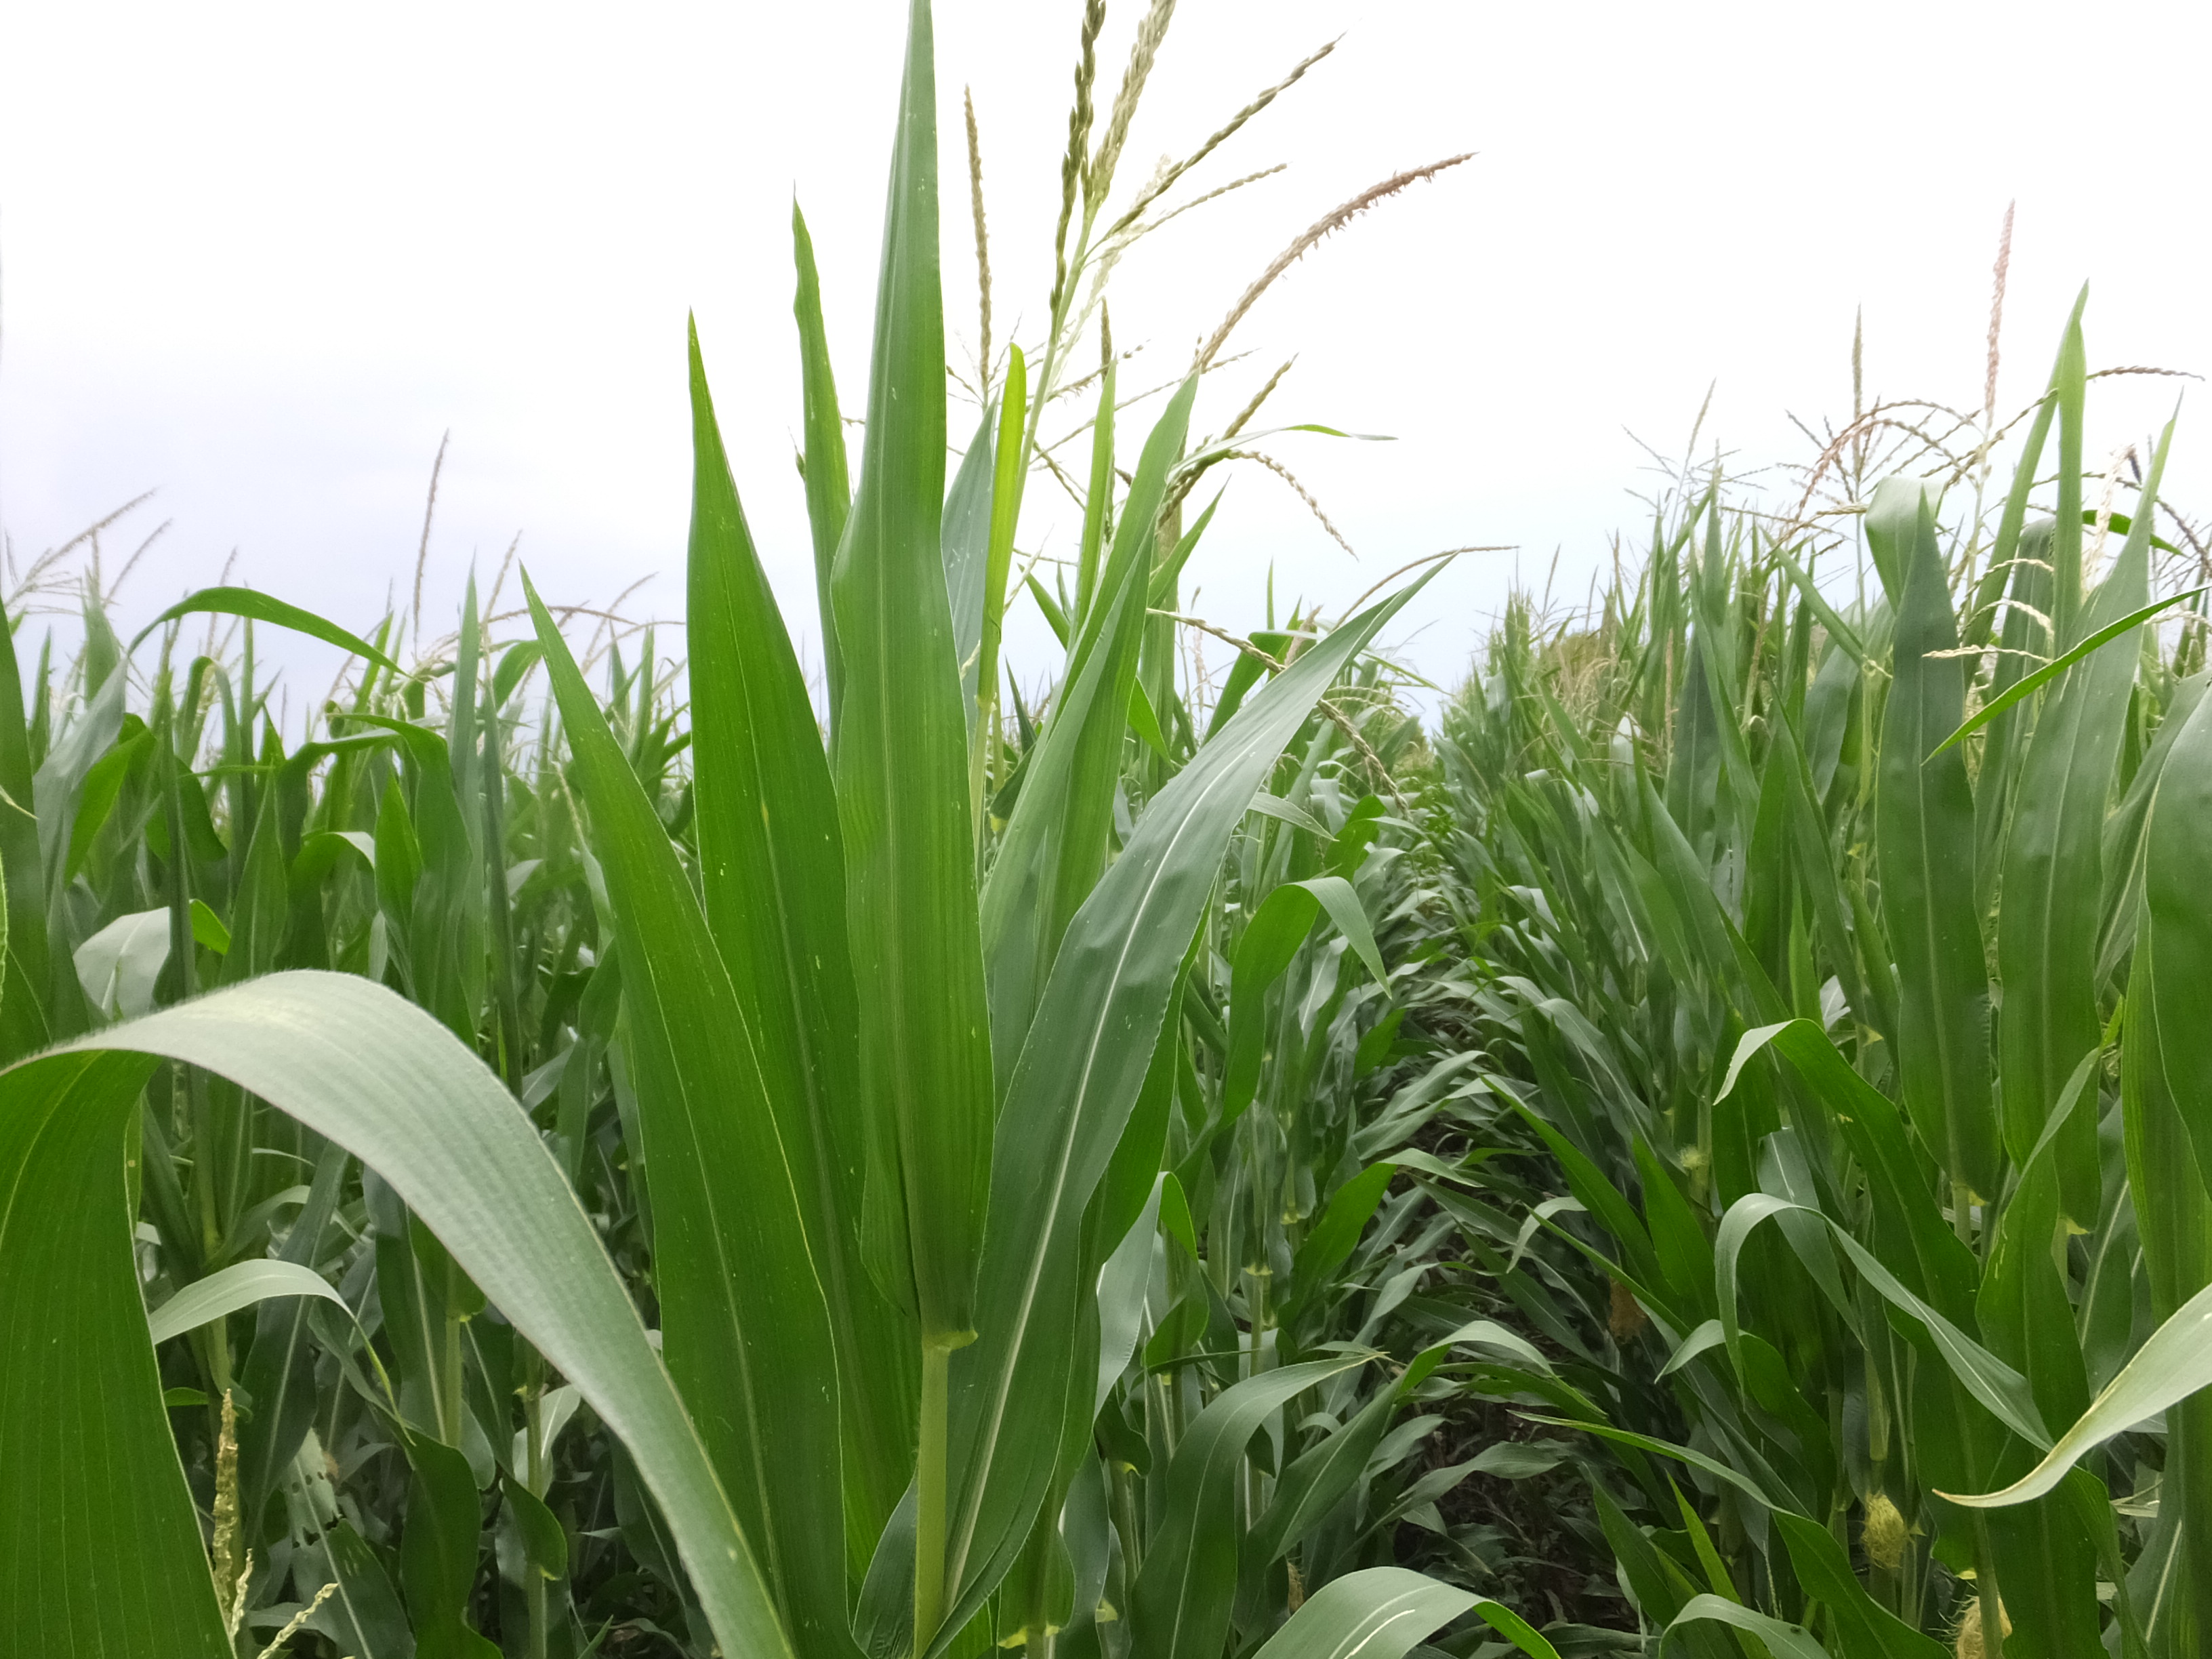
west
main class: Cropland
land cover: Maize
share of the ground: > 75 %
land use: Agriculture (excluding fallow land and kitchen gardens)
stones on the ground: < 10 %
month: July
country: ES
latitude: 41.4762
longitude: -0.0859
